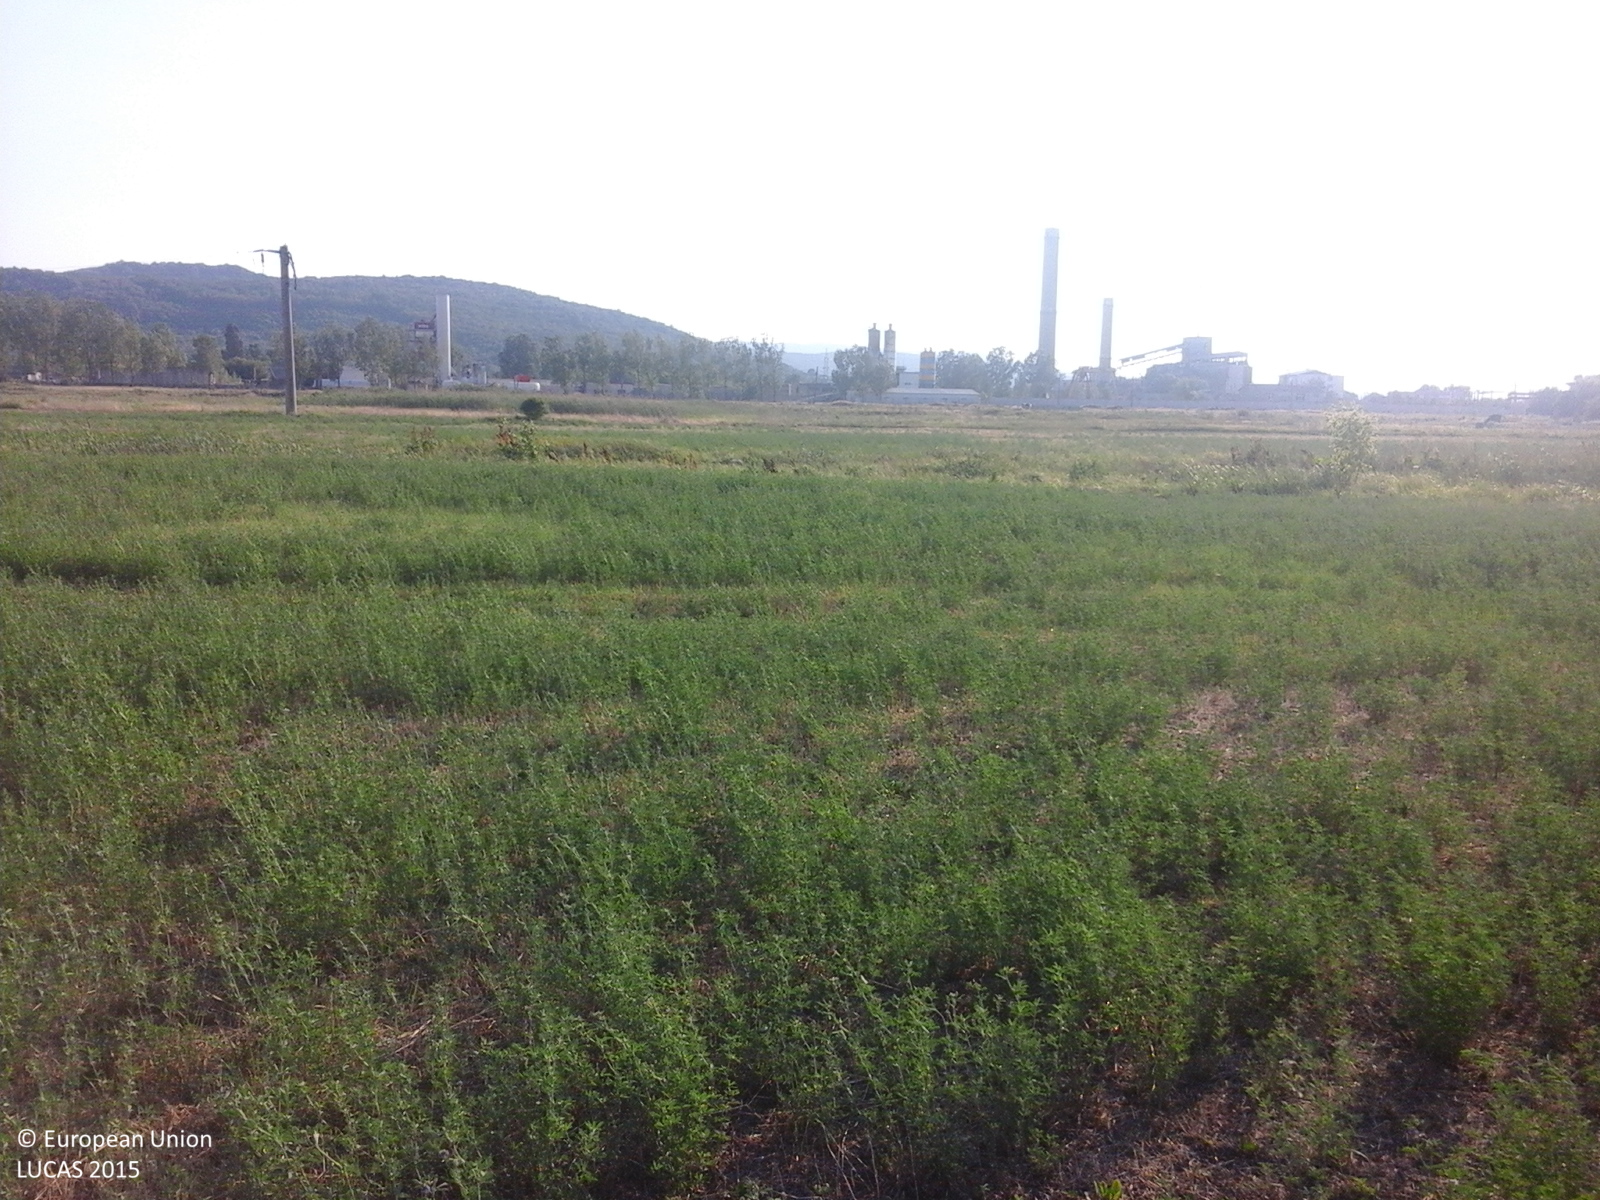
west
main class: Cropland
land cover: Lucerne
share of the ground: > 75 %
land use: Agriculture (excluding fallow land and kitchen gardens)
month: June
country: RO
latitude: 46.6223
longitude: 27.7363
